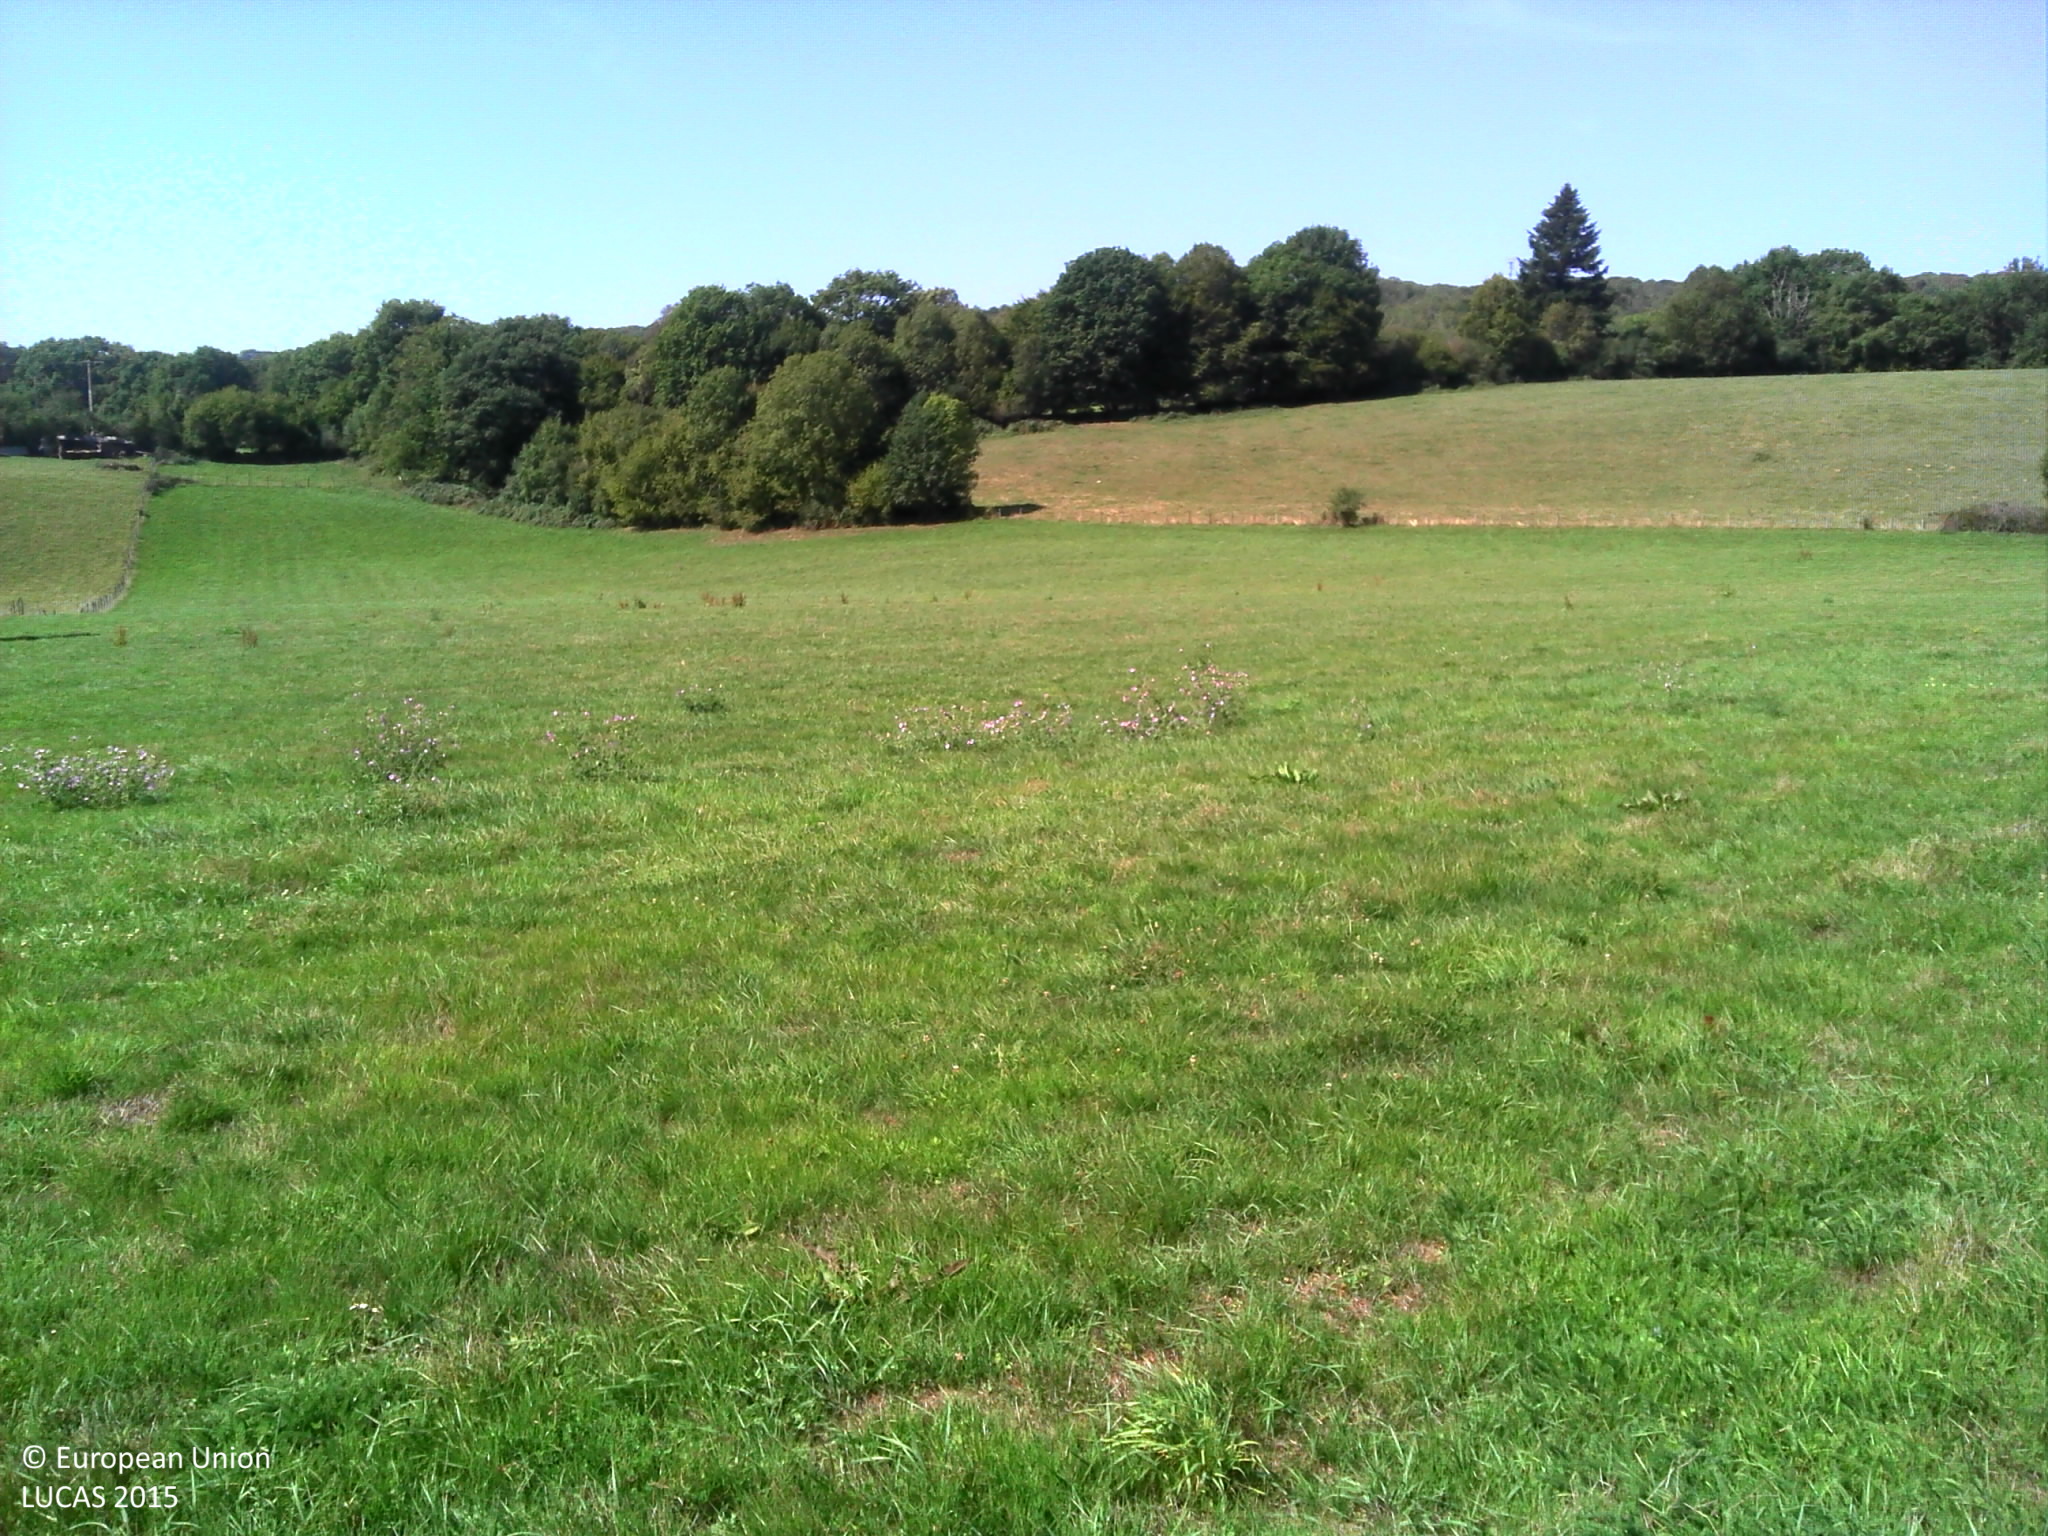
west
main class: Grassland
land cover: Grassland without tree/shrub cover
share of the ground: > 75 %
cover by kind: herbaceous plants 100 %
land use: Agriculture (excluding fallow land and kitchen gardens)
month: September
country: FR
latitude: 47.2868
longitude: 6.0219
